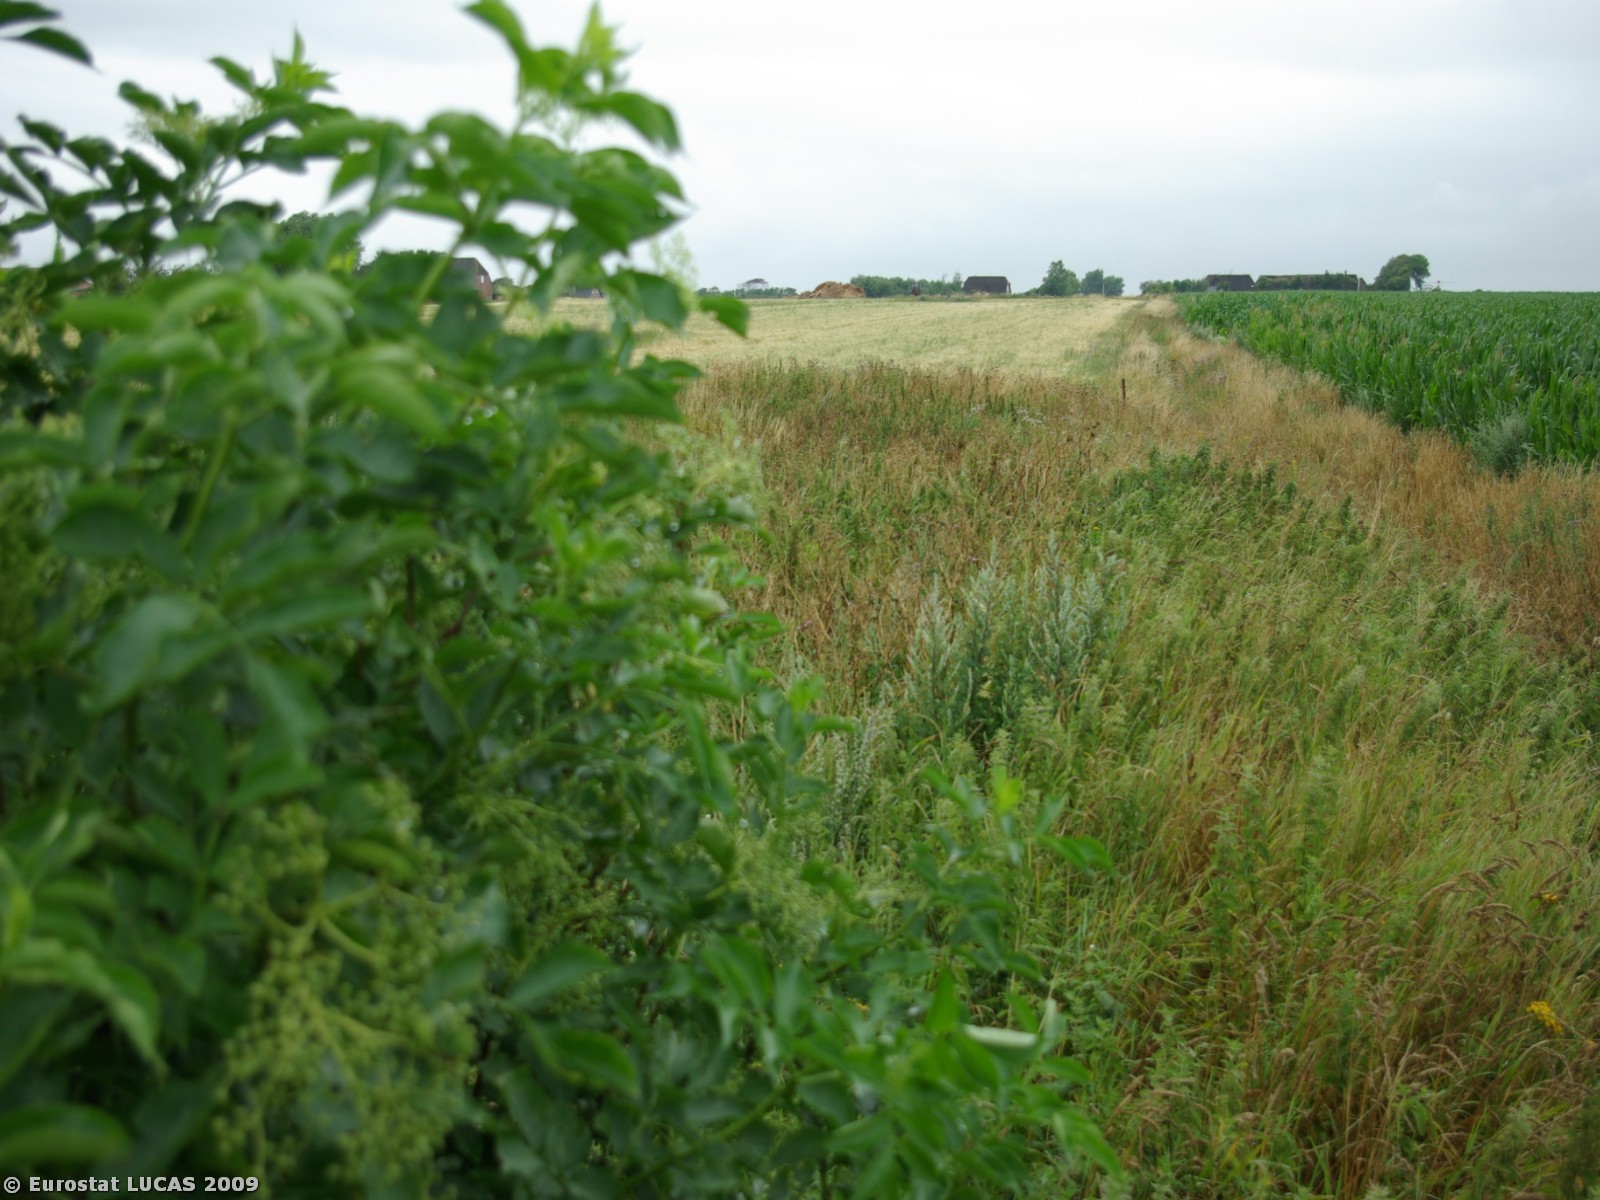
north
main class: Cropland
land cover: Maize
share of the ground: > 75 %
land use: Agriculture (excluding fallow land and kitchen gardens)
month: July
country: DK
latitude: 55.0843
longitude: 8.6694
